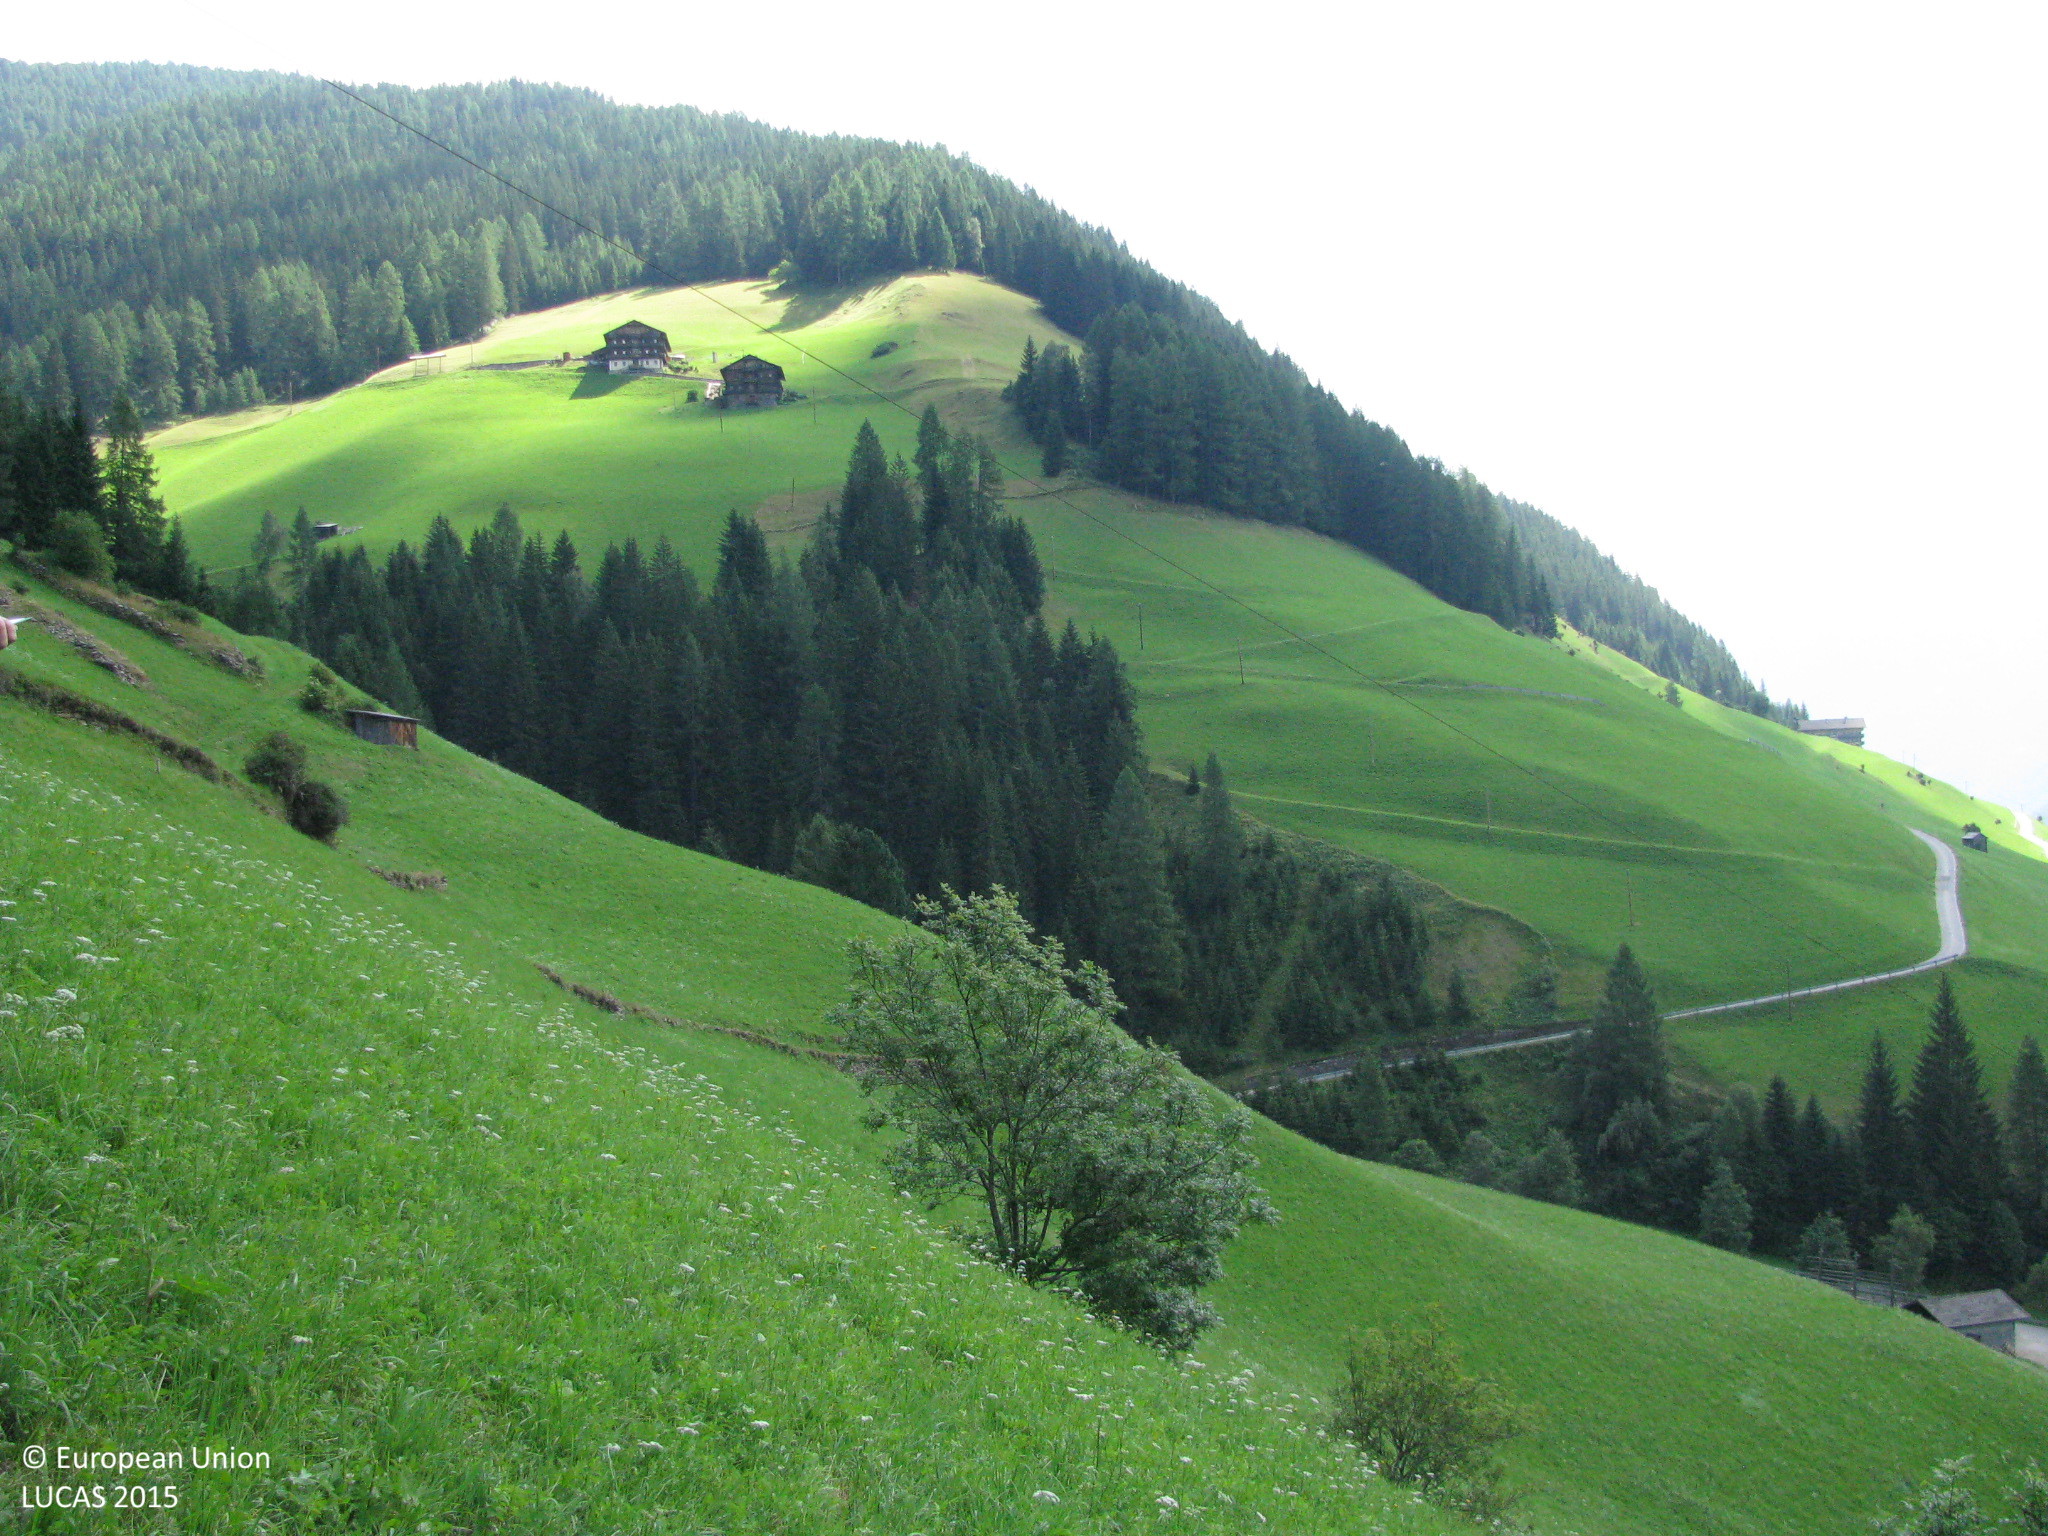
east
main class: Grassland
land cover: Grassland with sparse tree/shrub cover
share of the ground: > 75 %
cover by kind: herbaceous plants 95 %, broadleaved forest trees 5 %
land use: Agriculture (excluding fallow land and kitchen gardens)
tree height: < 5 m
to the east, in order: Grassland with sparse tree/shrub cover; Grassland without tree/shrub cover; Dry stone walls; Tracks; Dry stone walls; Grassland without tree/shrub cover; Grassland with sparse tree/shrub cover; Grassland without tree/shrub cover
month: July
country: AT
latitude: 46.8114
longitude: 12.3698
